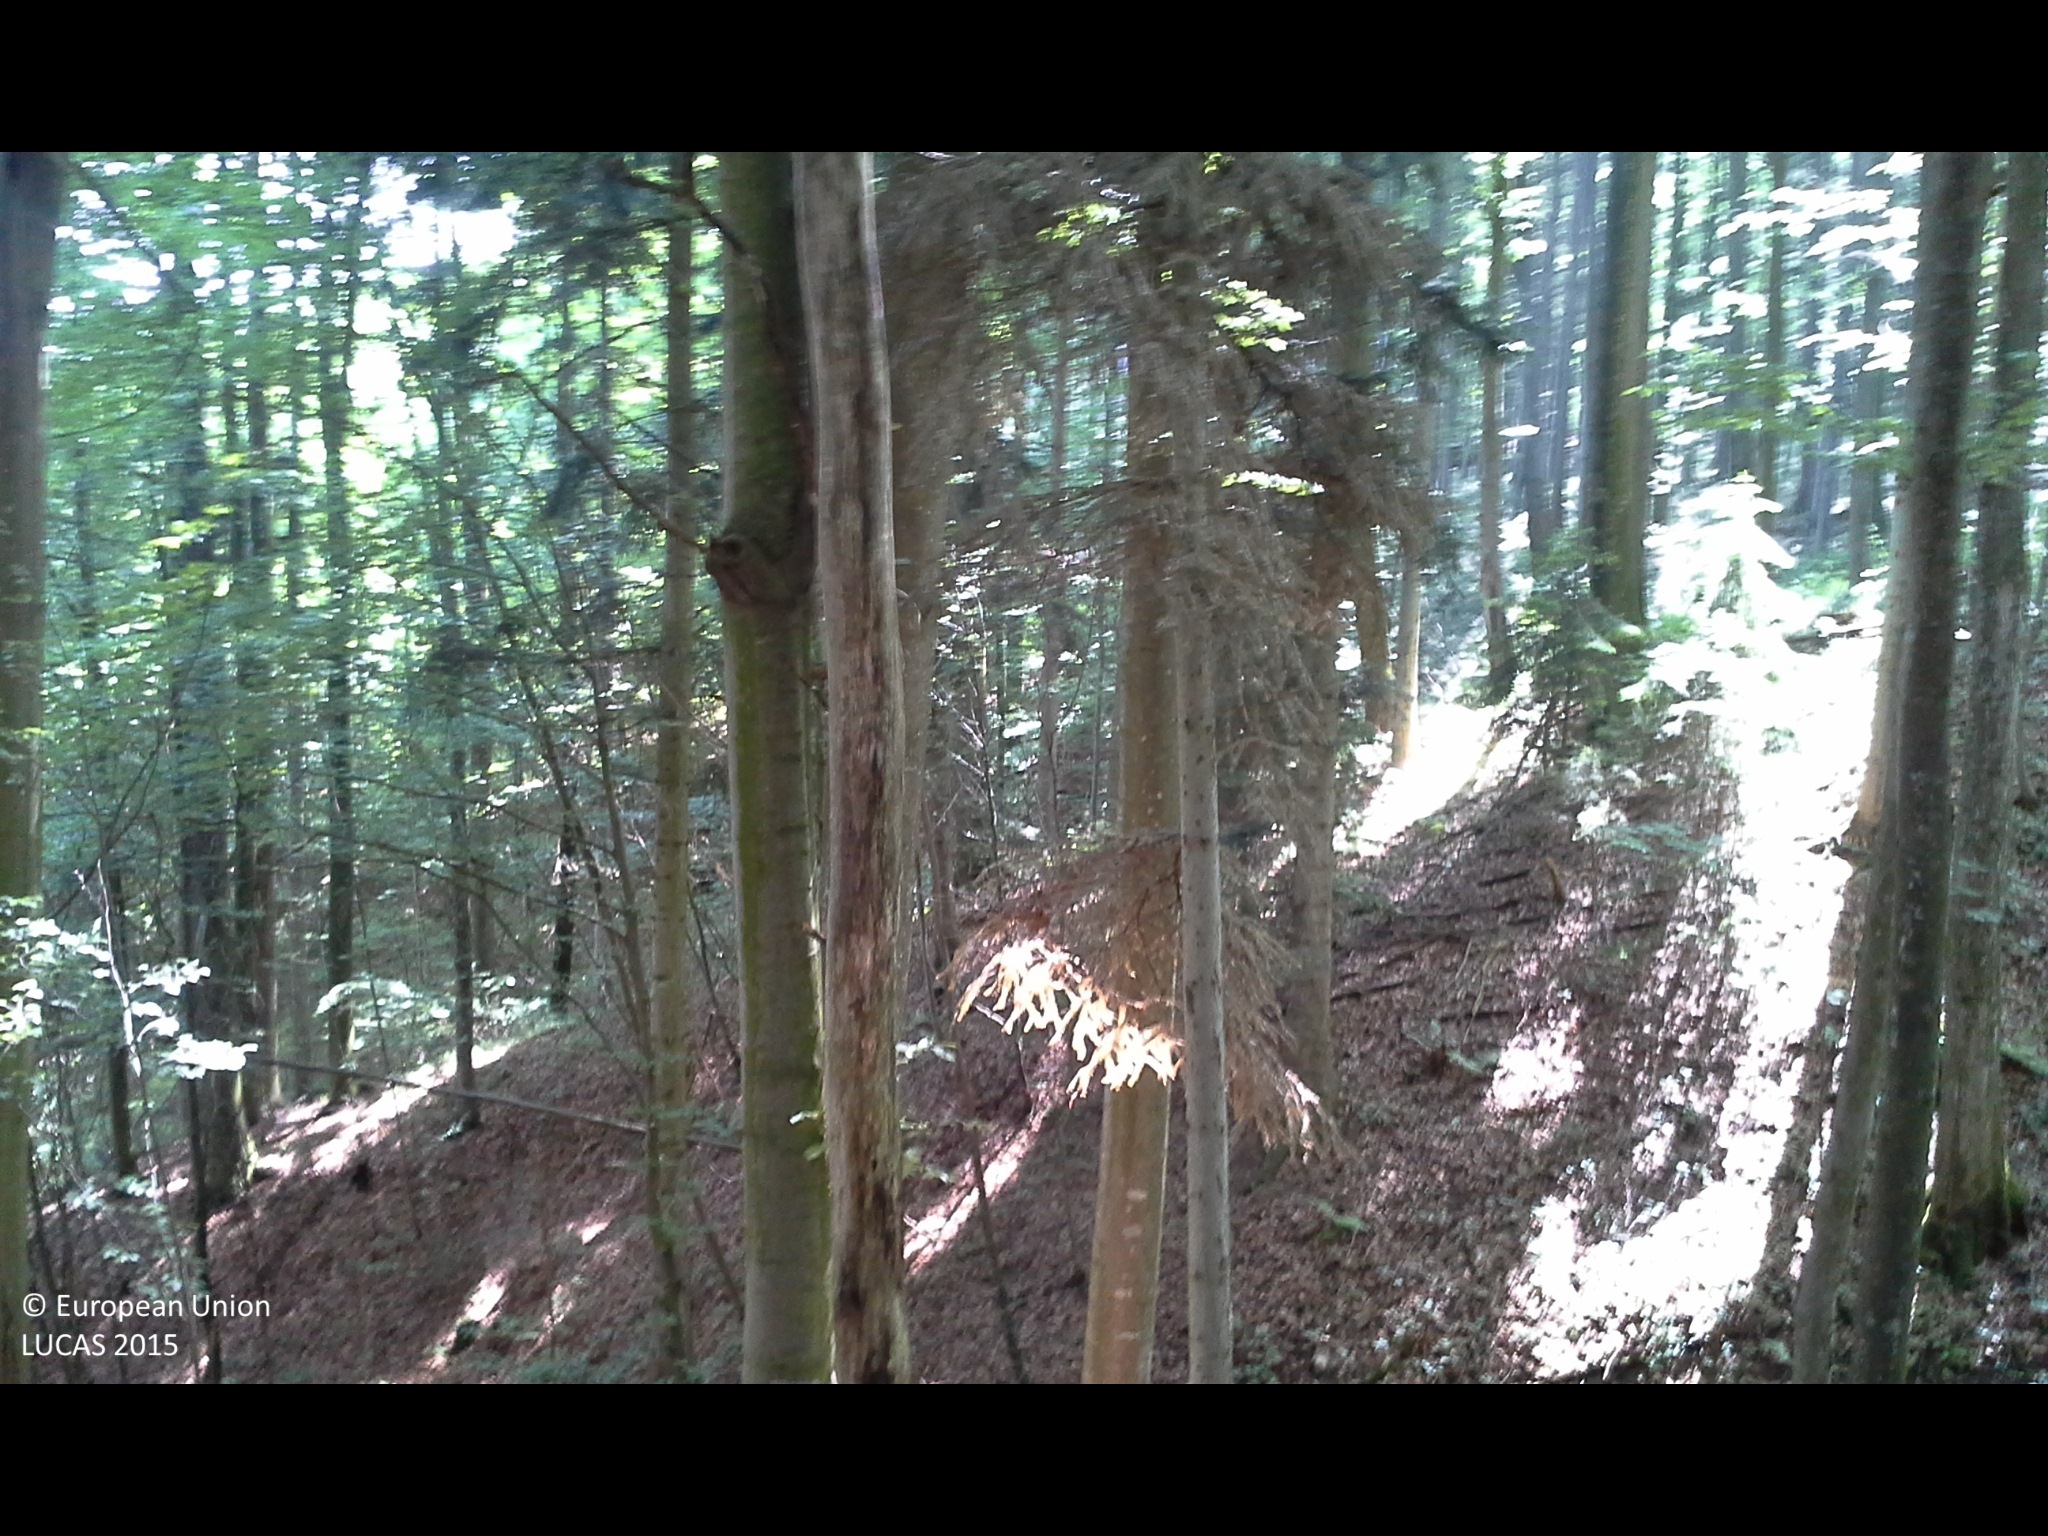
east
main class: Woodland
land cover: Spruce dominated mixed woodland
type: mountainous beech forest
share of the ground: > 75 %
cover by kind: coniferous forest trees 50 %, broadleaved forest trees 50 %
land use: Forestry
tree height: > 5 m
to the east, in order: Spruce dominated mixed woodland; Rivers and streams; Spruce dominated mixed woodland; Rivers and streams; Spruce dominated mixed woodland; Fences; Spruce dominated coniferous woodland; Spruce dominated mixed woodland; Fences; Tracks; Broadleaved woodland
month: May
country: AT
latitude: 47.9647
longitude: 14.1649
